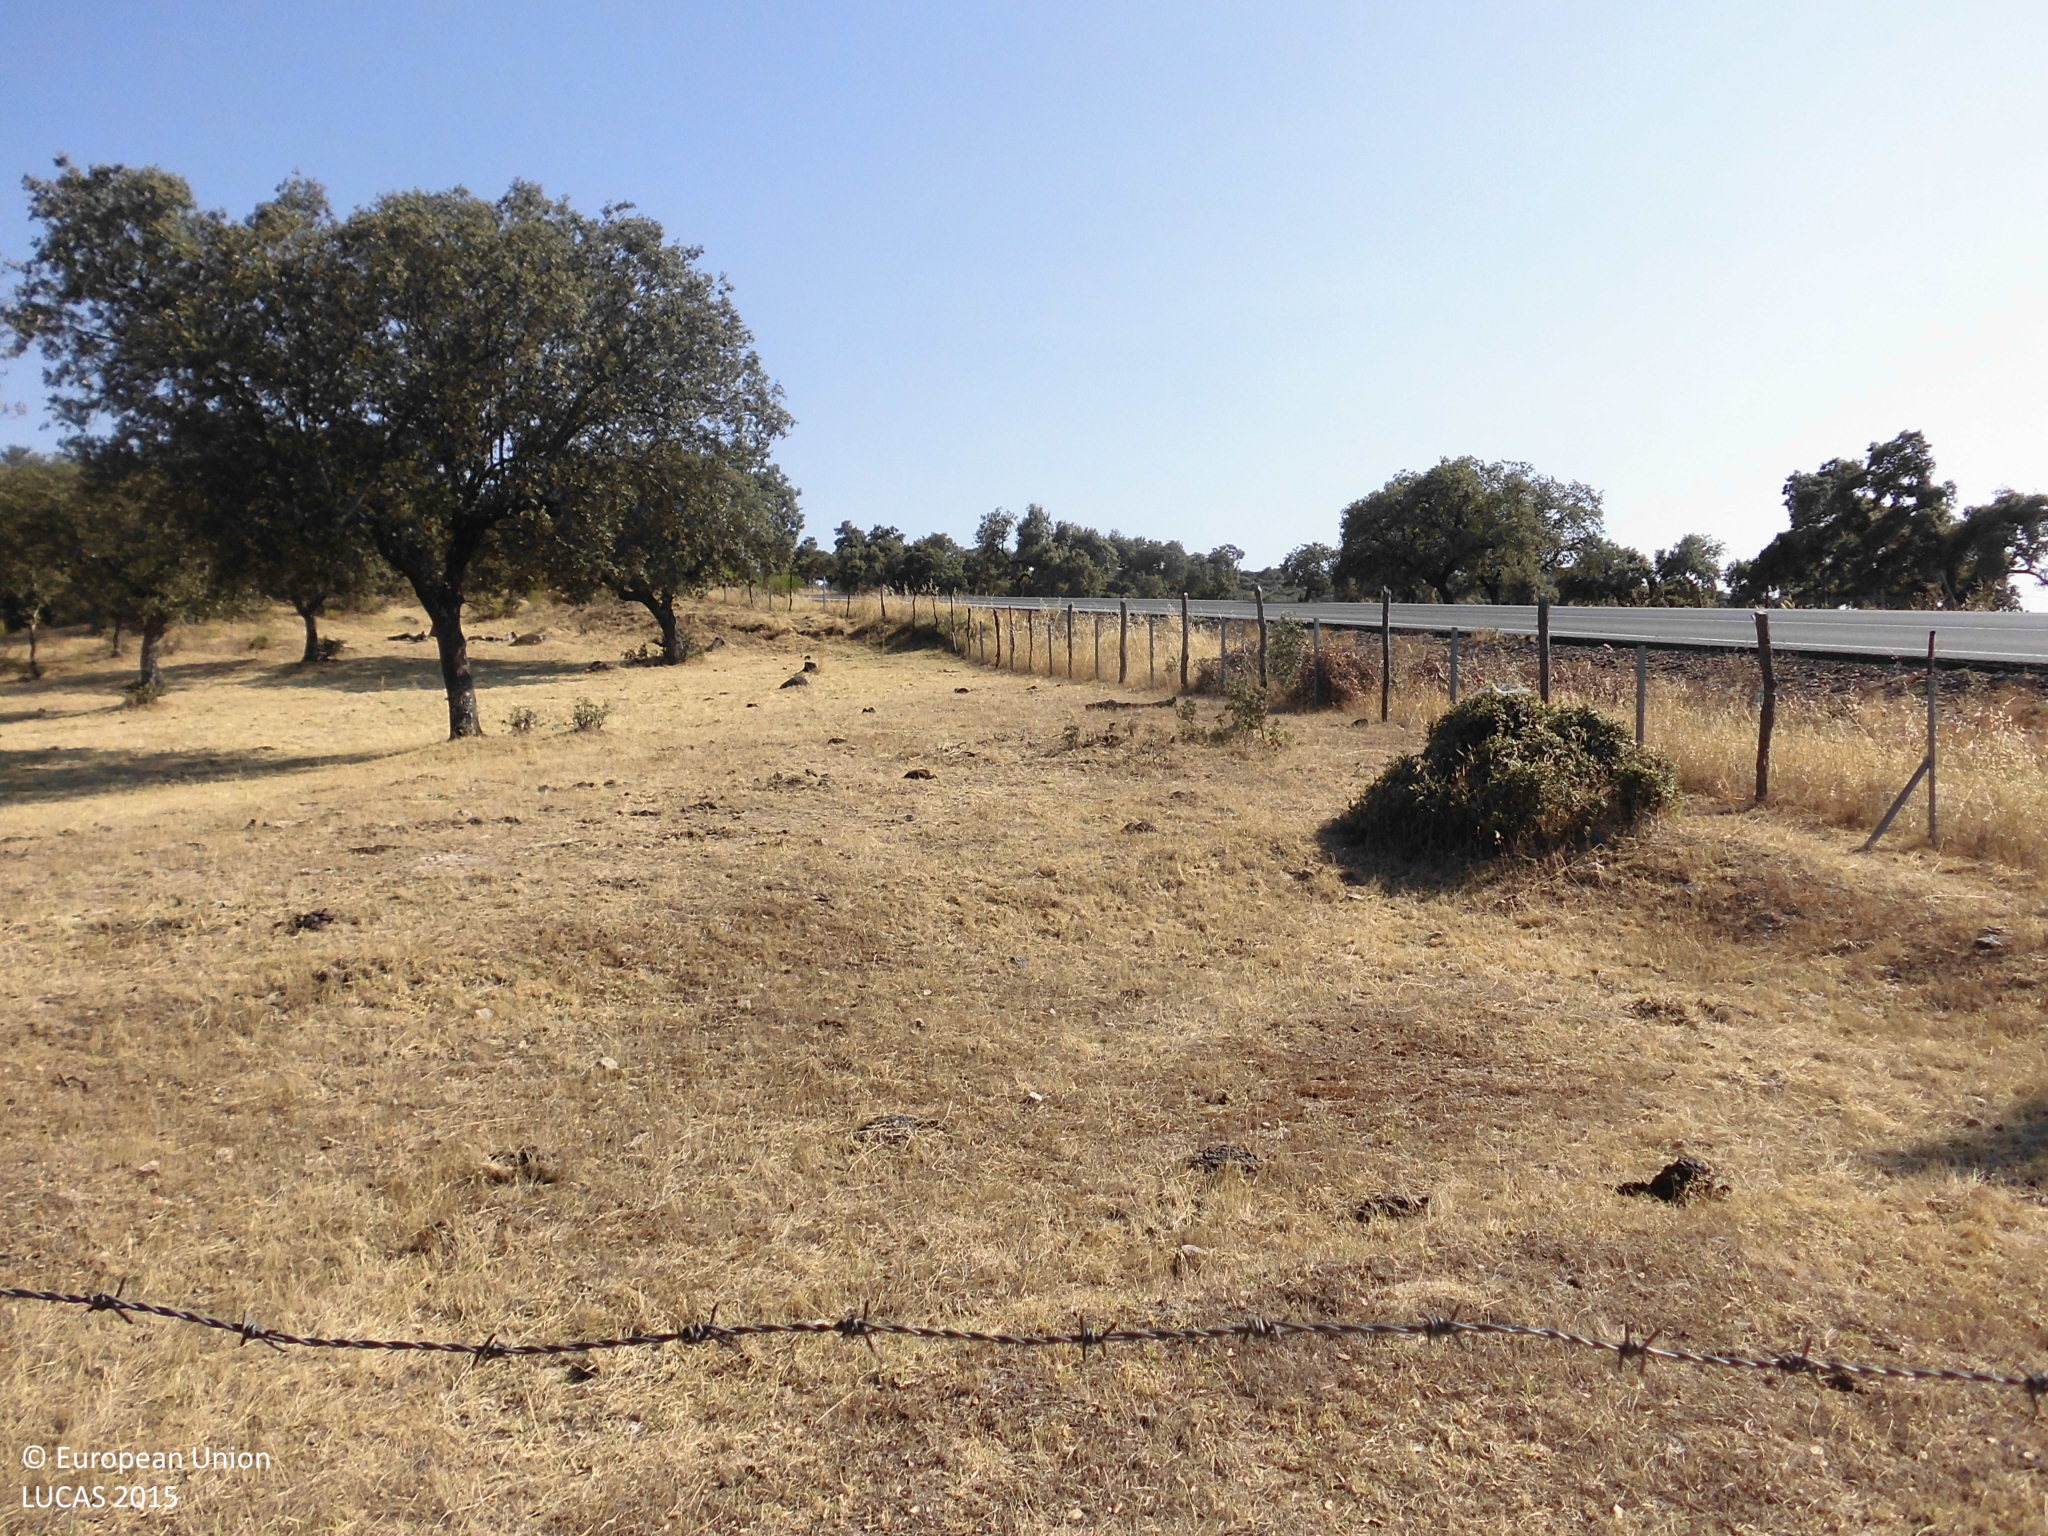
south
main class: Woodland
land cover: Broadleaved woodland
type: broadleaved evergreen forest
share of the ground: 25 - 50 %
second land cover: Grassland without tree/shrub cover
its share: > 75 %
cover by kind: herbaceous plants 55 %, broadleaved forest trees 45 %
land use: Forestry
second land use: Agriculture (excluding fallow land and kitchen gardens)
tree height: > 5 m
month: July
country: ES
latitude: 40.0903
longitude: -6.0820
